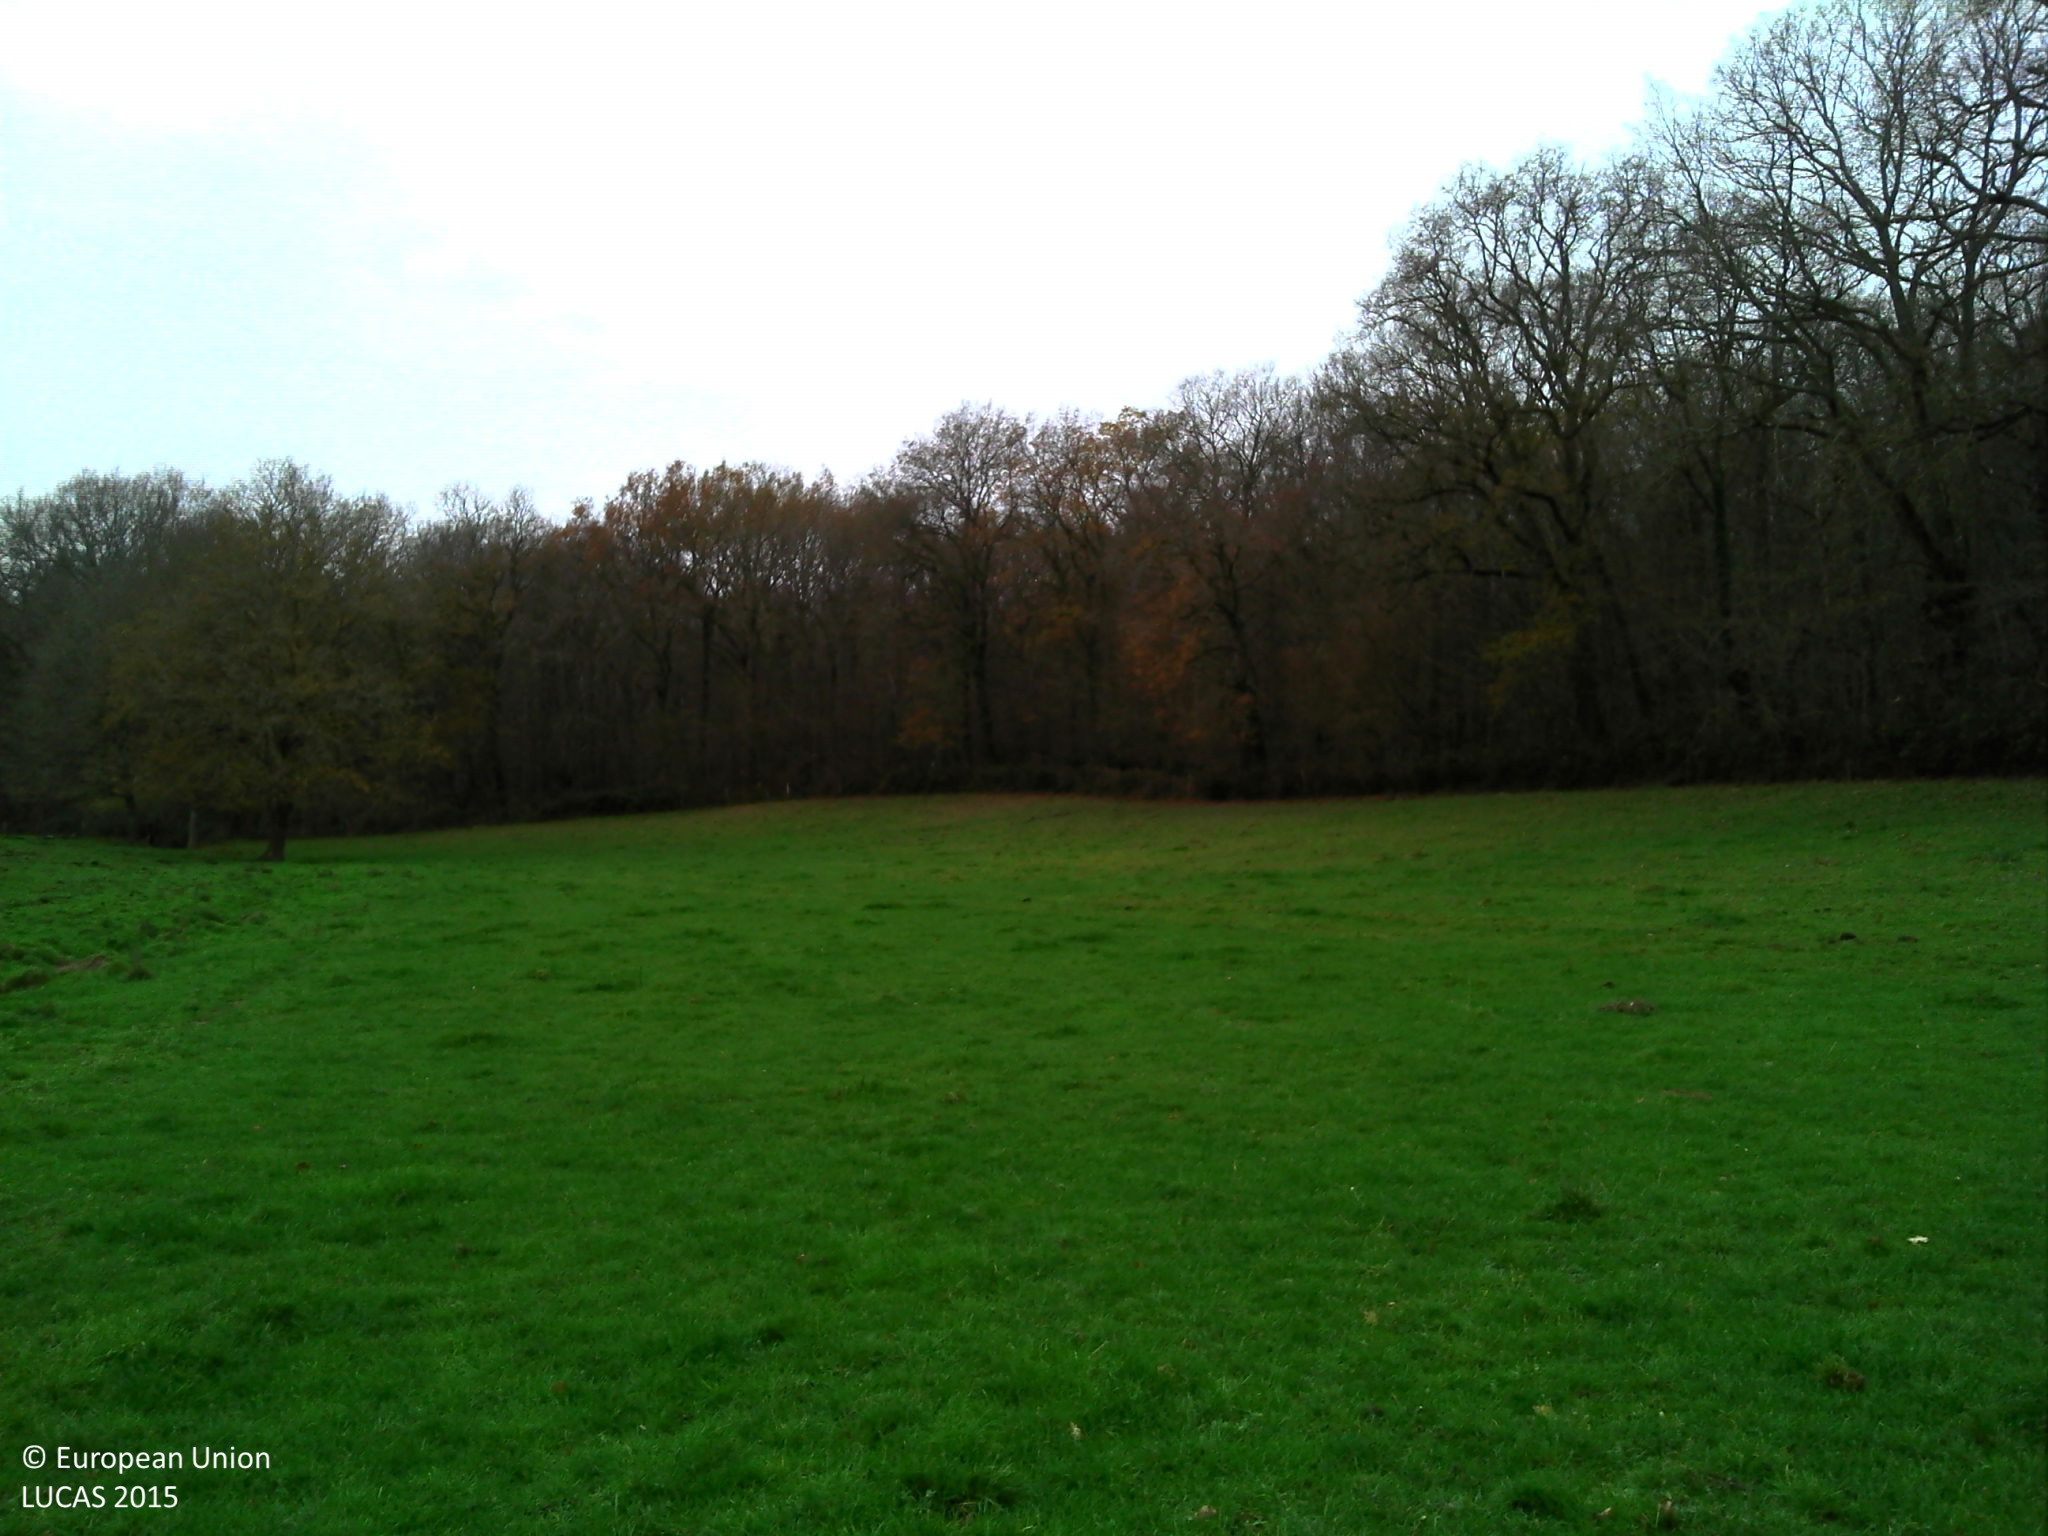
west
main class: Grassland
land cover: Grassland without tree/shrub cover
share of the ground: > 75 %
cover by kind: herbaceous plants 100 %
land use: Agriculture (excluding fallow land and kitchen gardens)
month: July
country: FR
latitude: 46.6822
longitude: 3.0020
